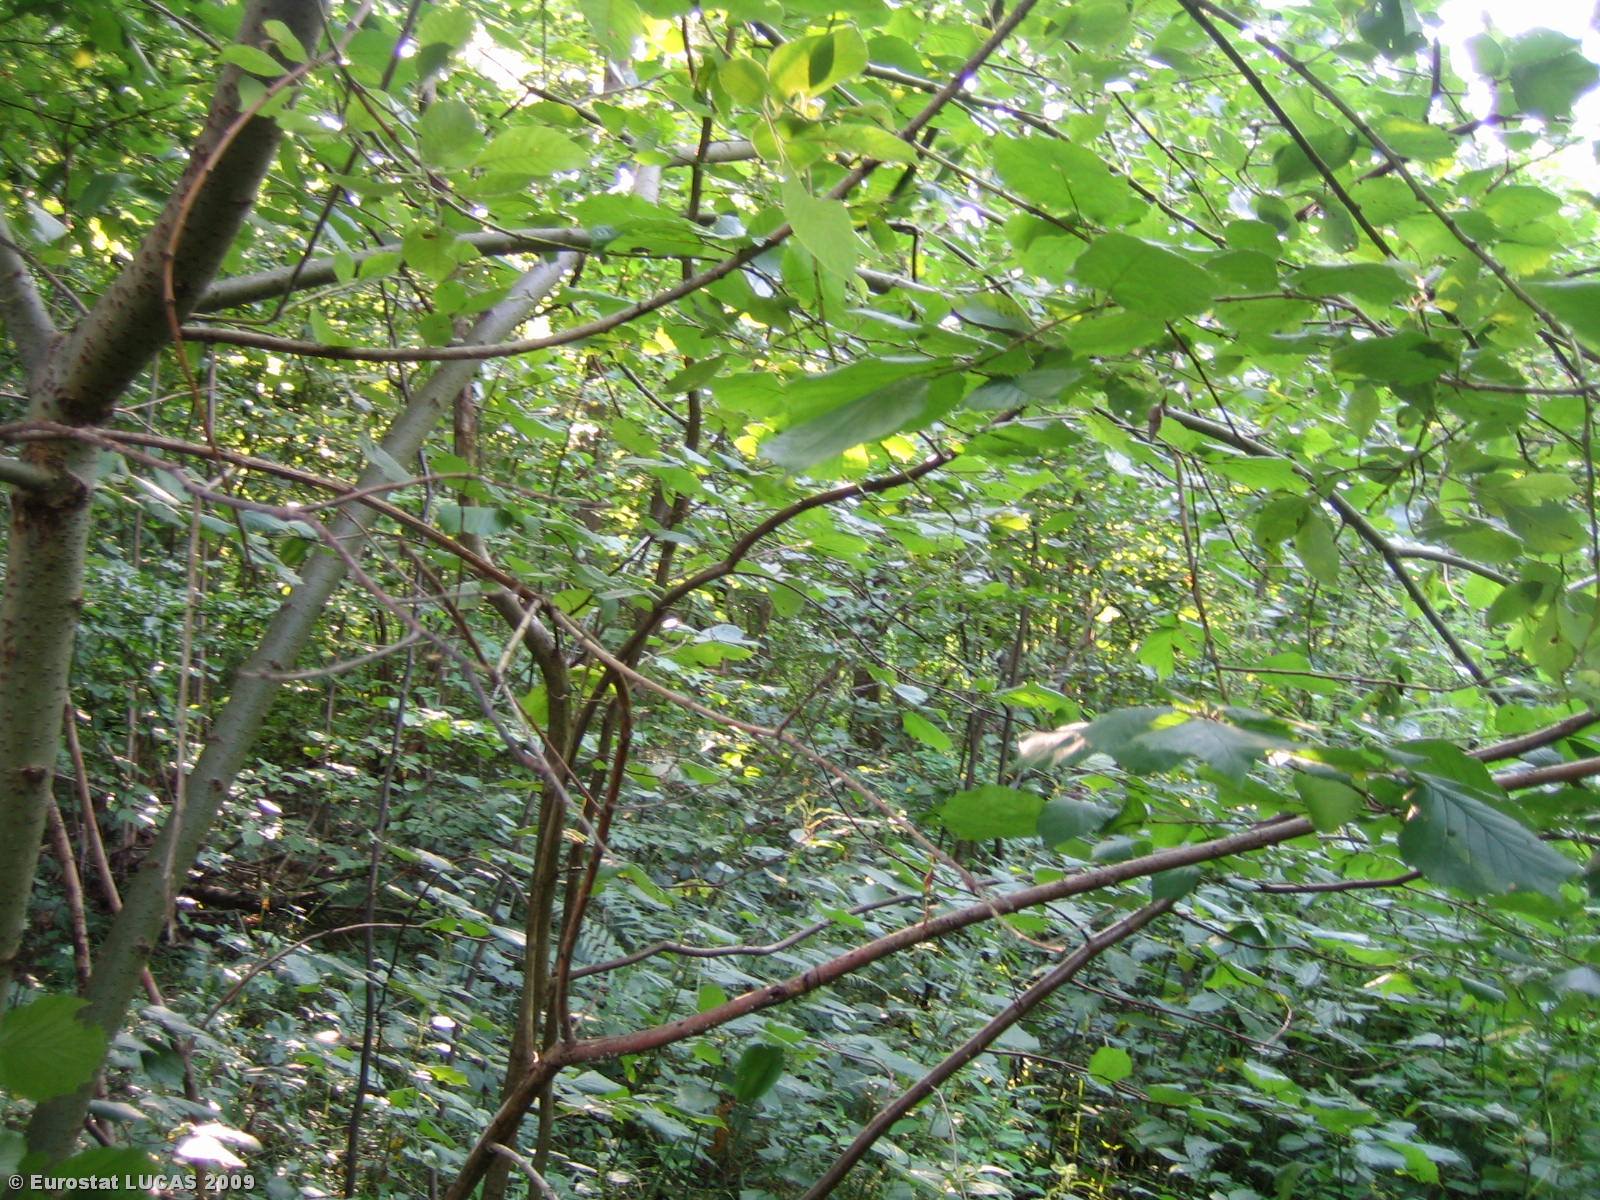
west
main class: Woodland
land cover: Mixed woodland
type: hemiboreal forest and nemoral coniferous forest and mixed broadleaved-coniferous forest
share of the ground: > 75 %
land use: Forestry
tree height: > 5 m
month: August
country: LT
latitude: 54.6656
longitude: 24.4744
